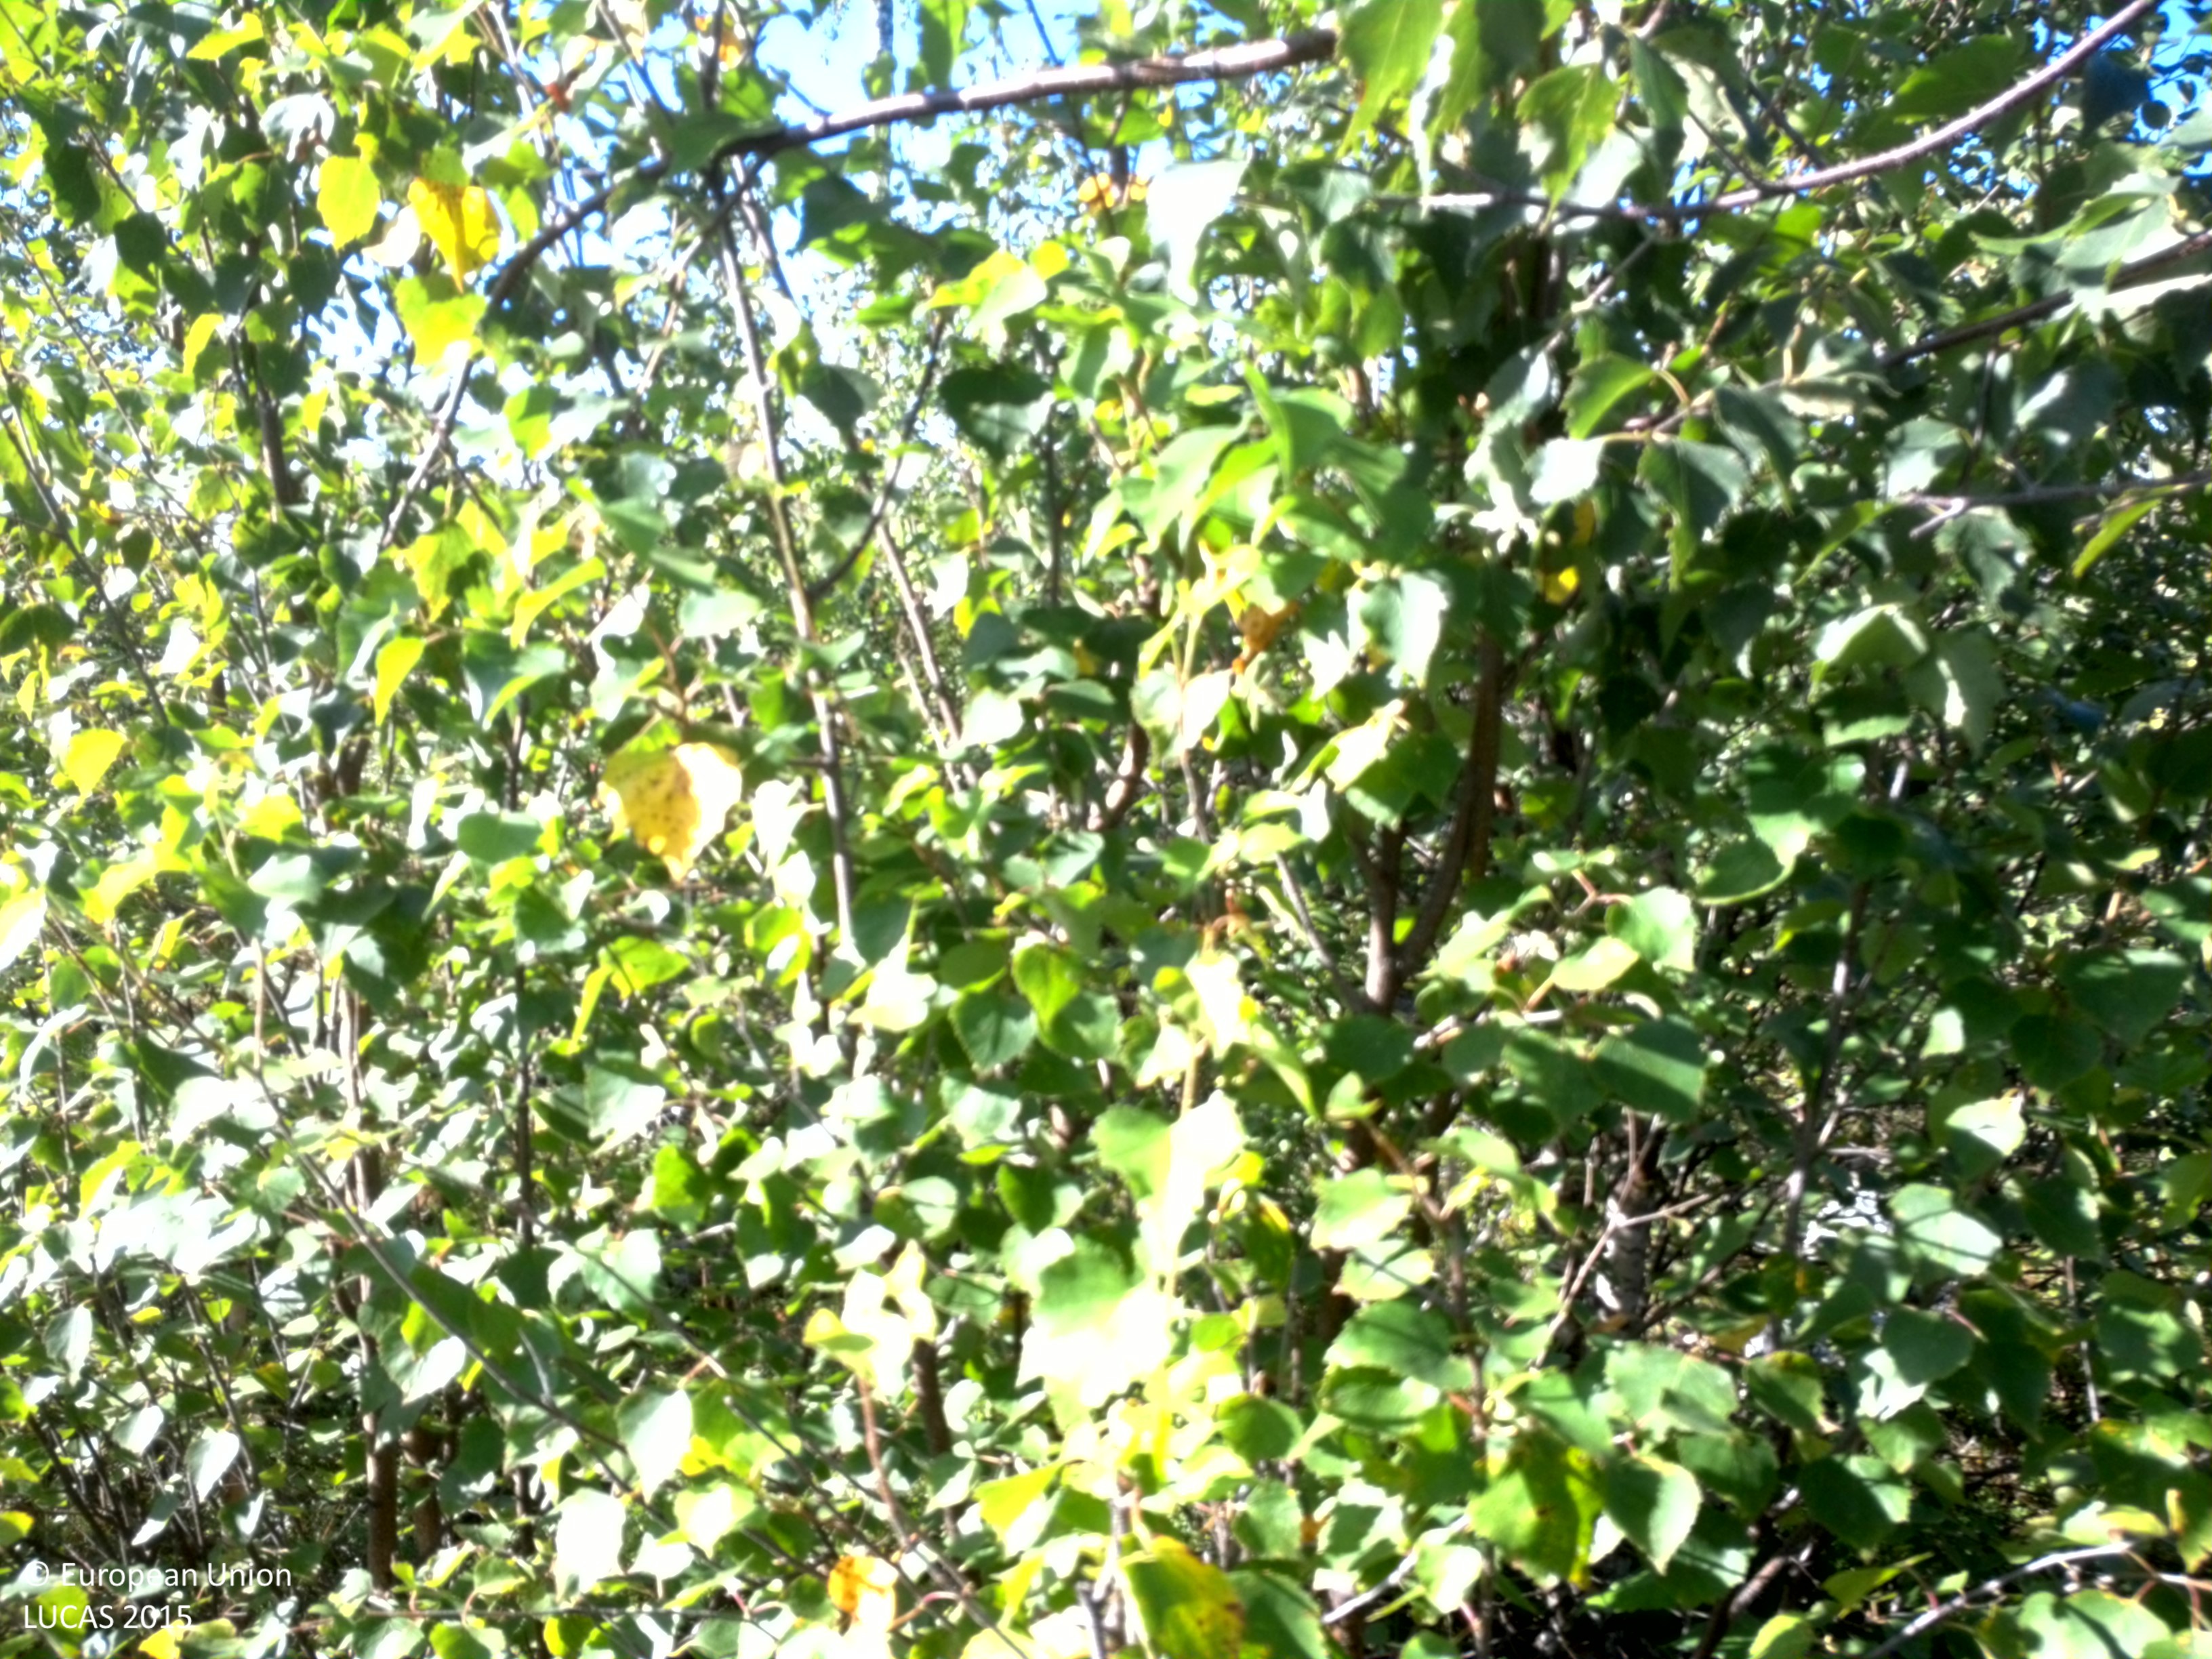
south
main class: Woodland
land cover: Broadleaved woodland
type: boreal forest
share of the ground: > 75 %
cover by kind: broadleaved forest trees 75 %, coniferous forest trees 10 %, shrubs 10 %, herbaceous plants 5 %
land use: Forestry
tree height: < 5 m
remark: Clear cut
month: August
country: SE
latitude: 64.5005
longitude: 20.5745
